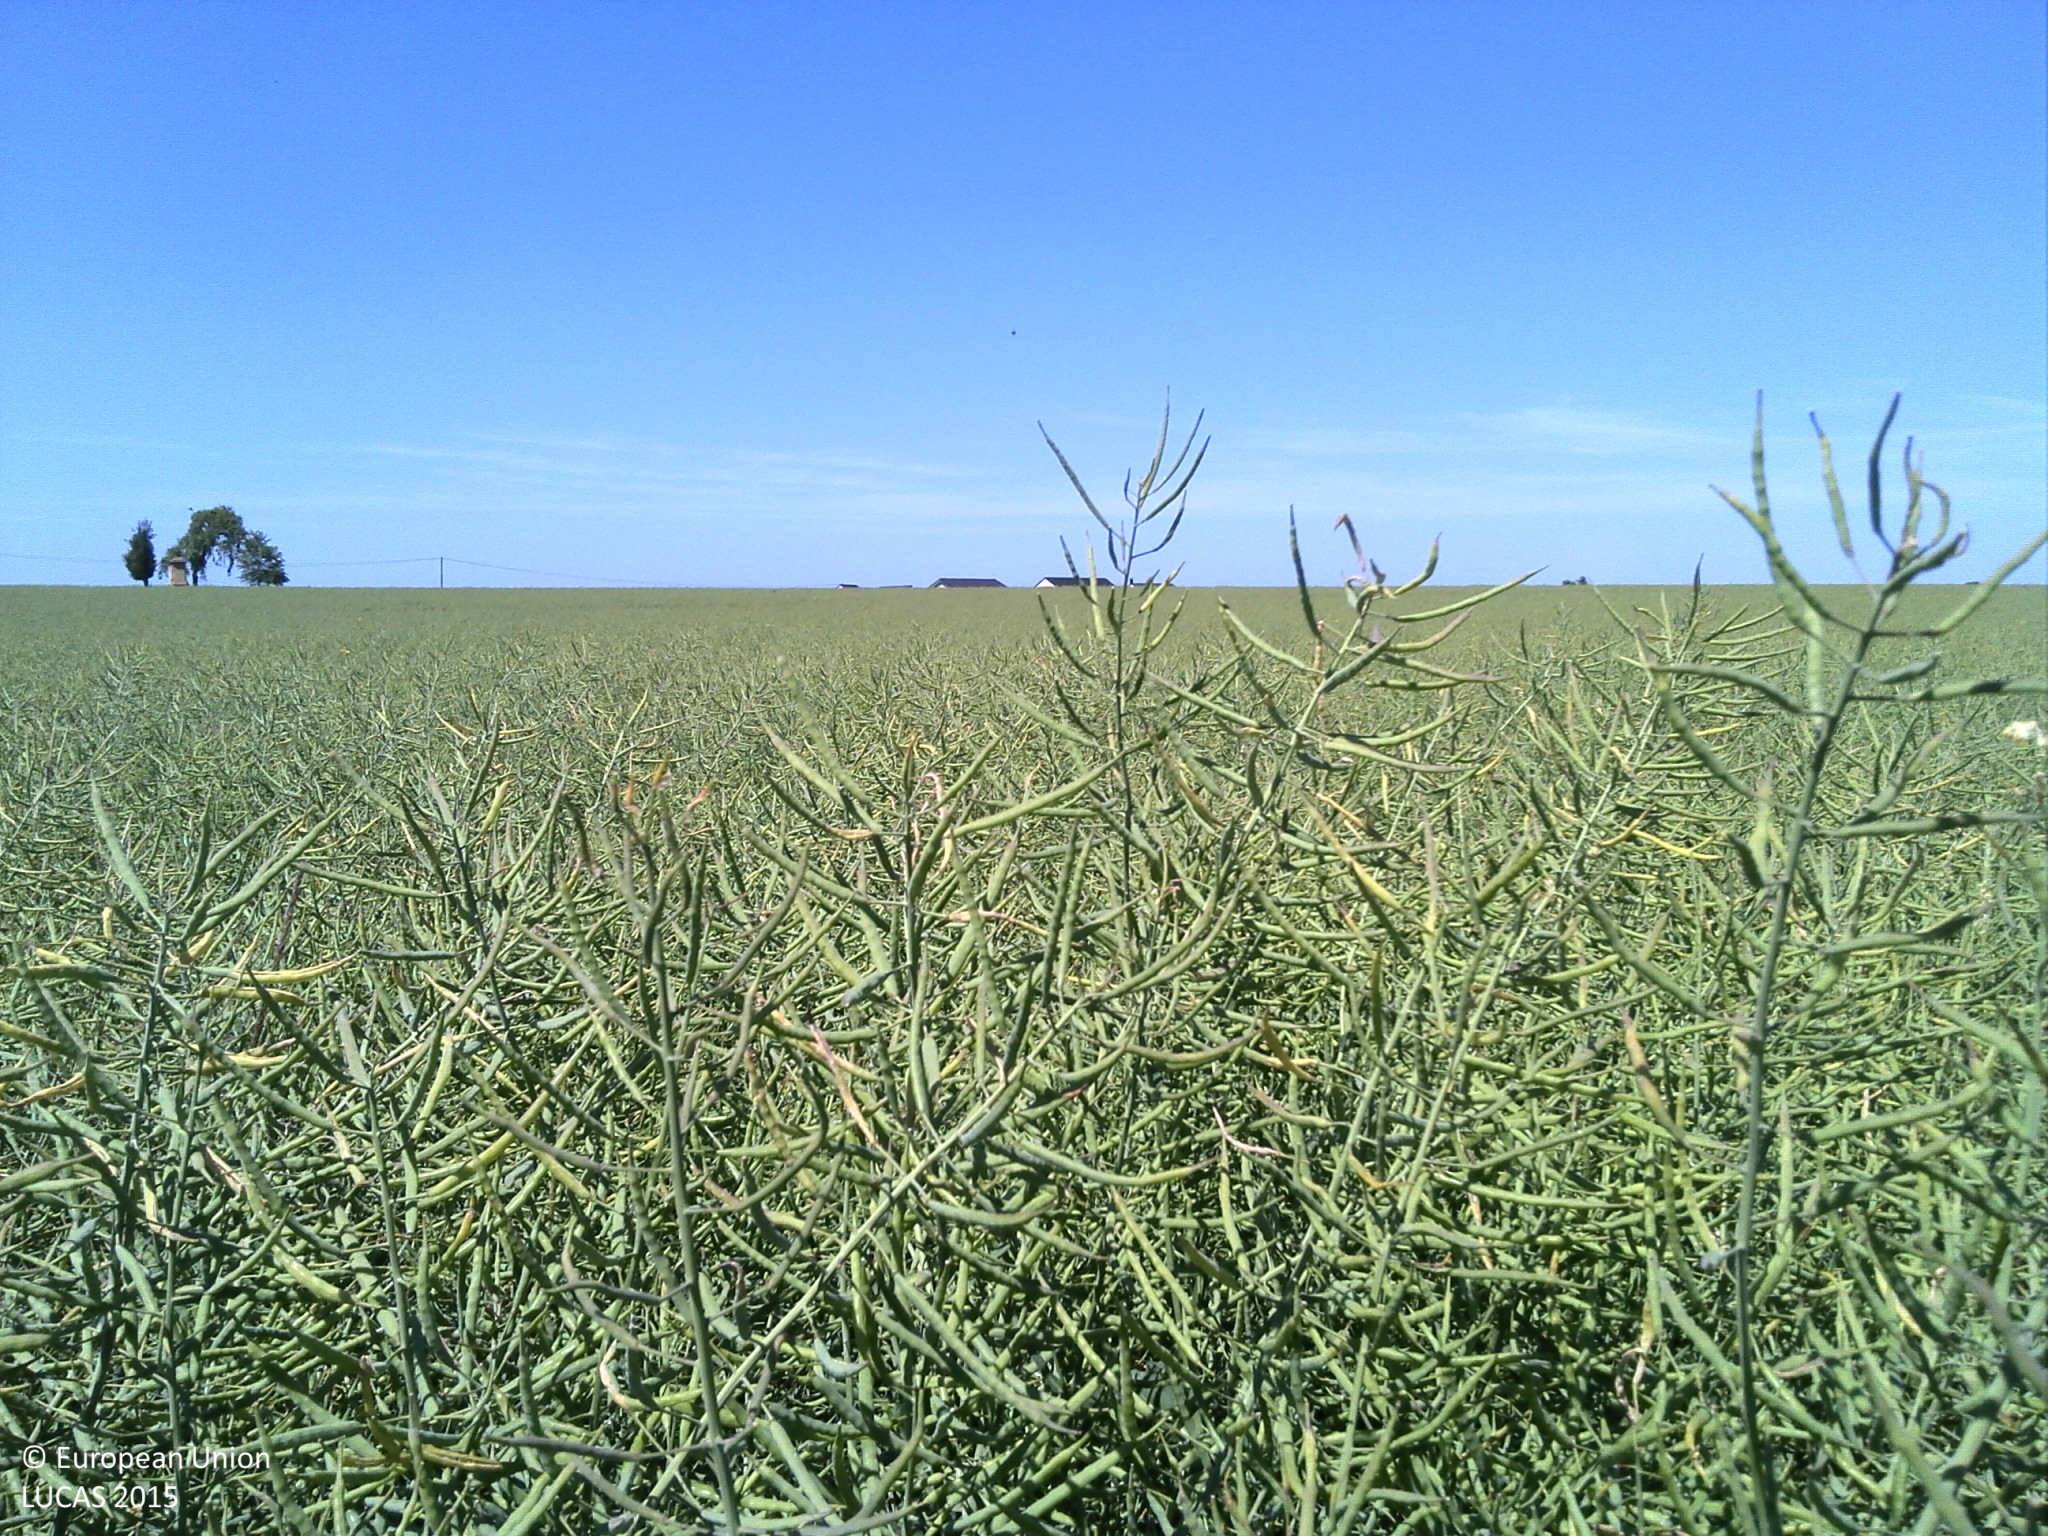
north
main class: Cropland
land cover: Rape and turnip rape
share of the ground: > 75 %
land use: Agriculture (excluding fallow land and kitchen gardens)
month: June
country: FR
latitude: 49.1610
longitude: 6.0364
